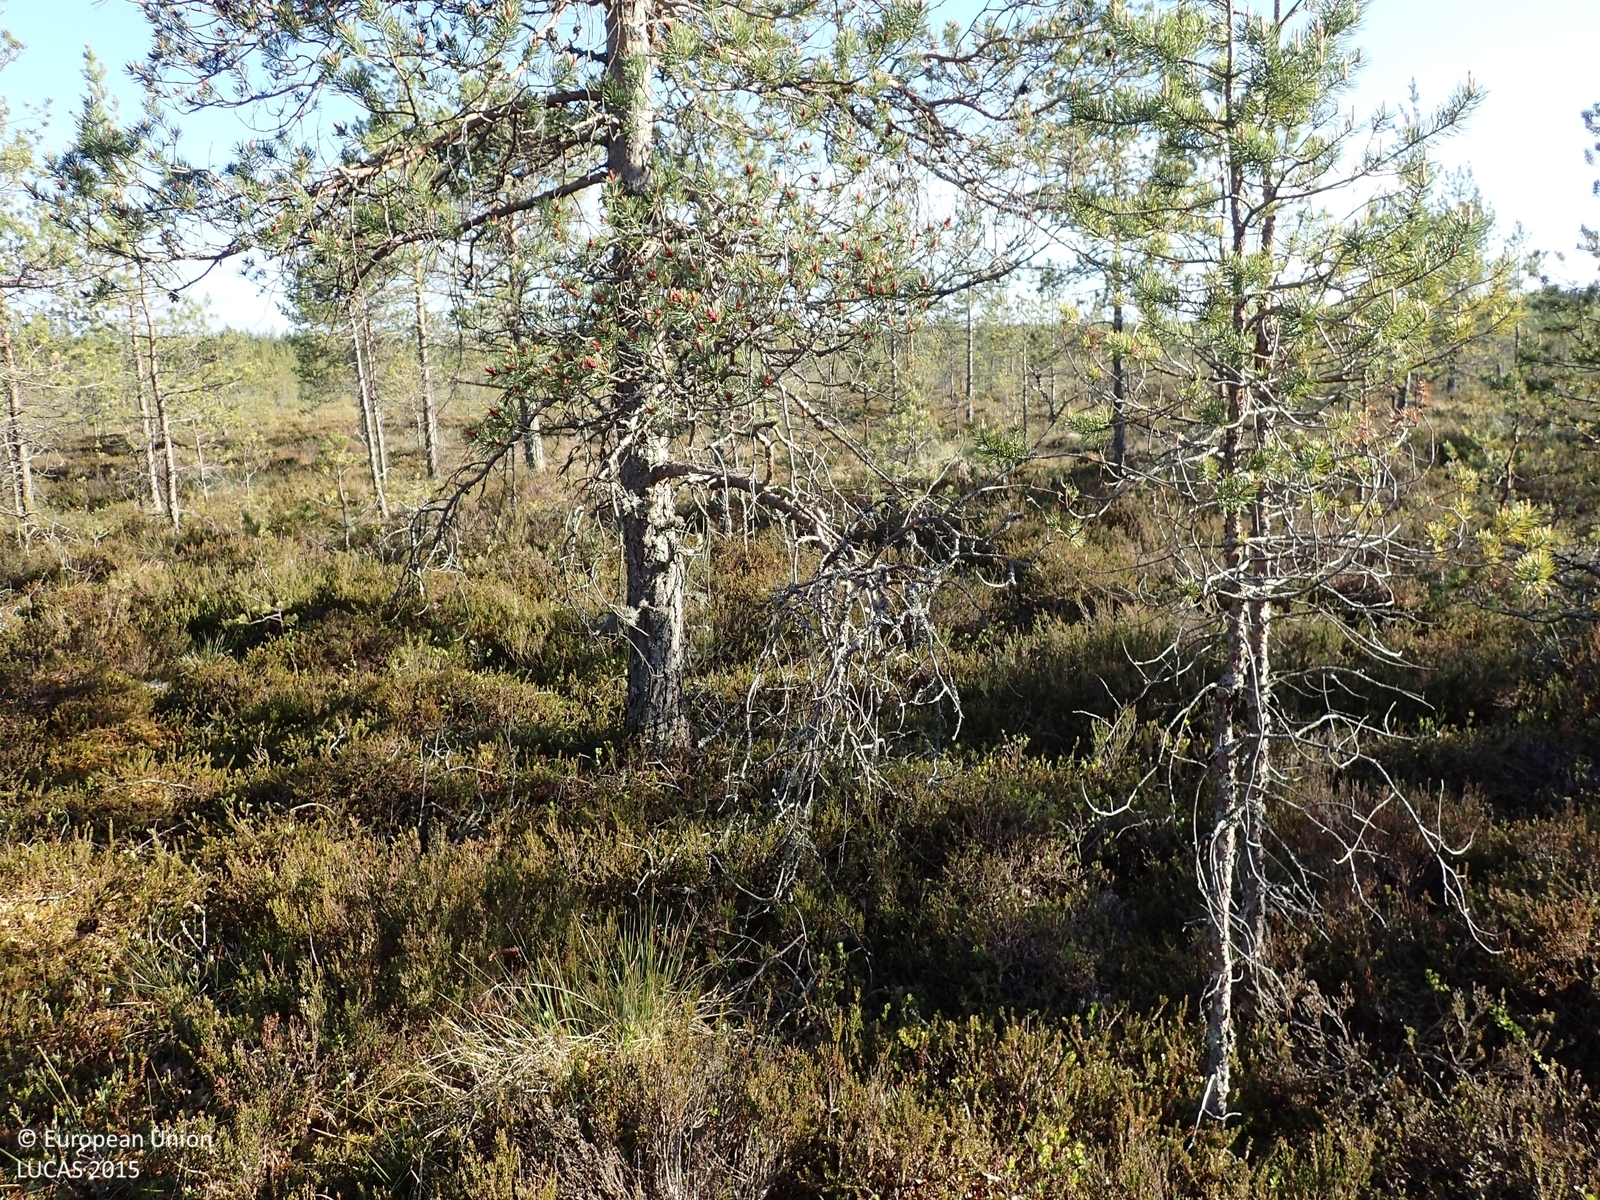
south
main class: Woodland
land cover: Pine dominated coniferous woodland
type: boreal forest
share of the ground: 50 - 75 %
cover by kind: coniferous forest trees 50 %, shrubs 50 %
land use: Forestry
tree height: > 5 m
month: June
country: FI
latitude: 62.2050
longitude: 21.7553
